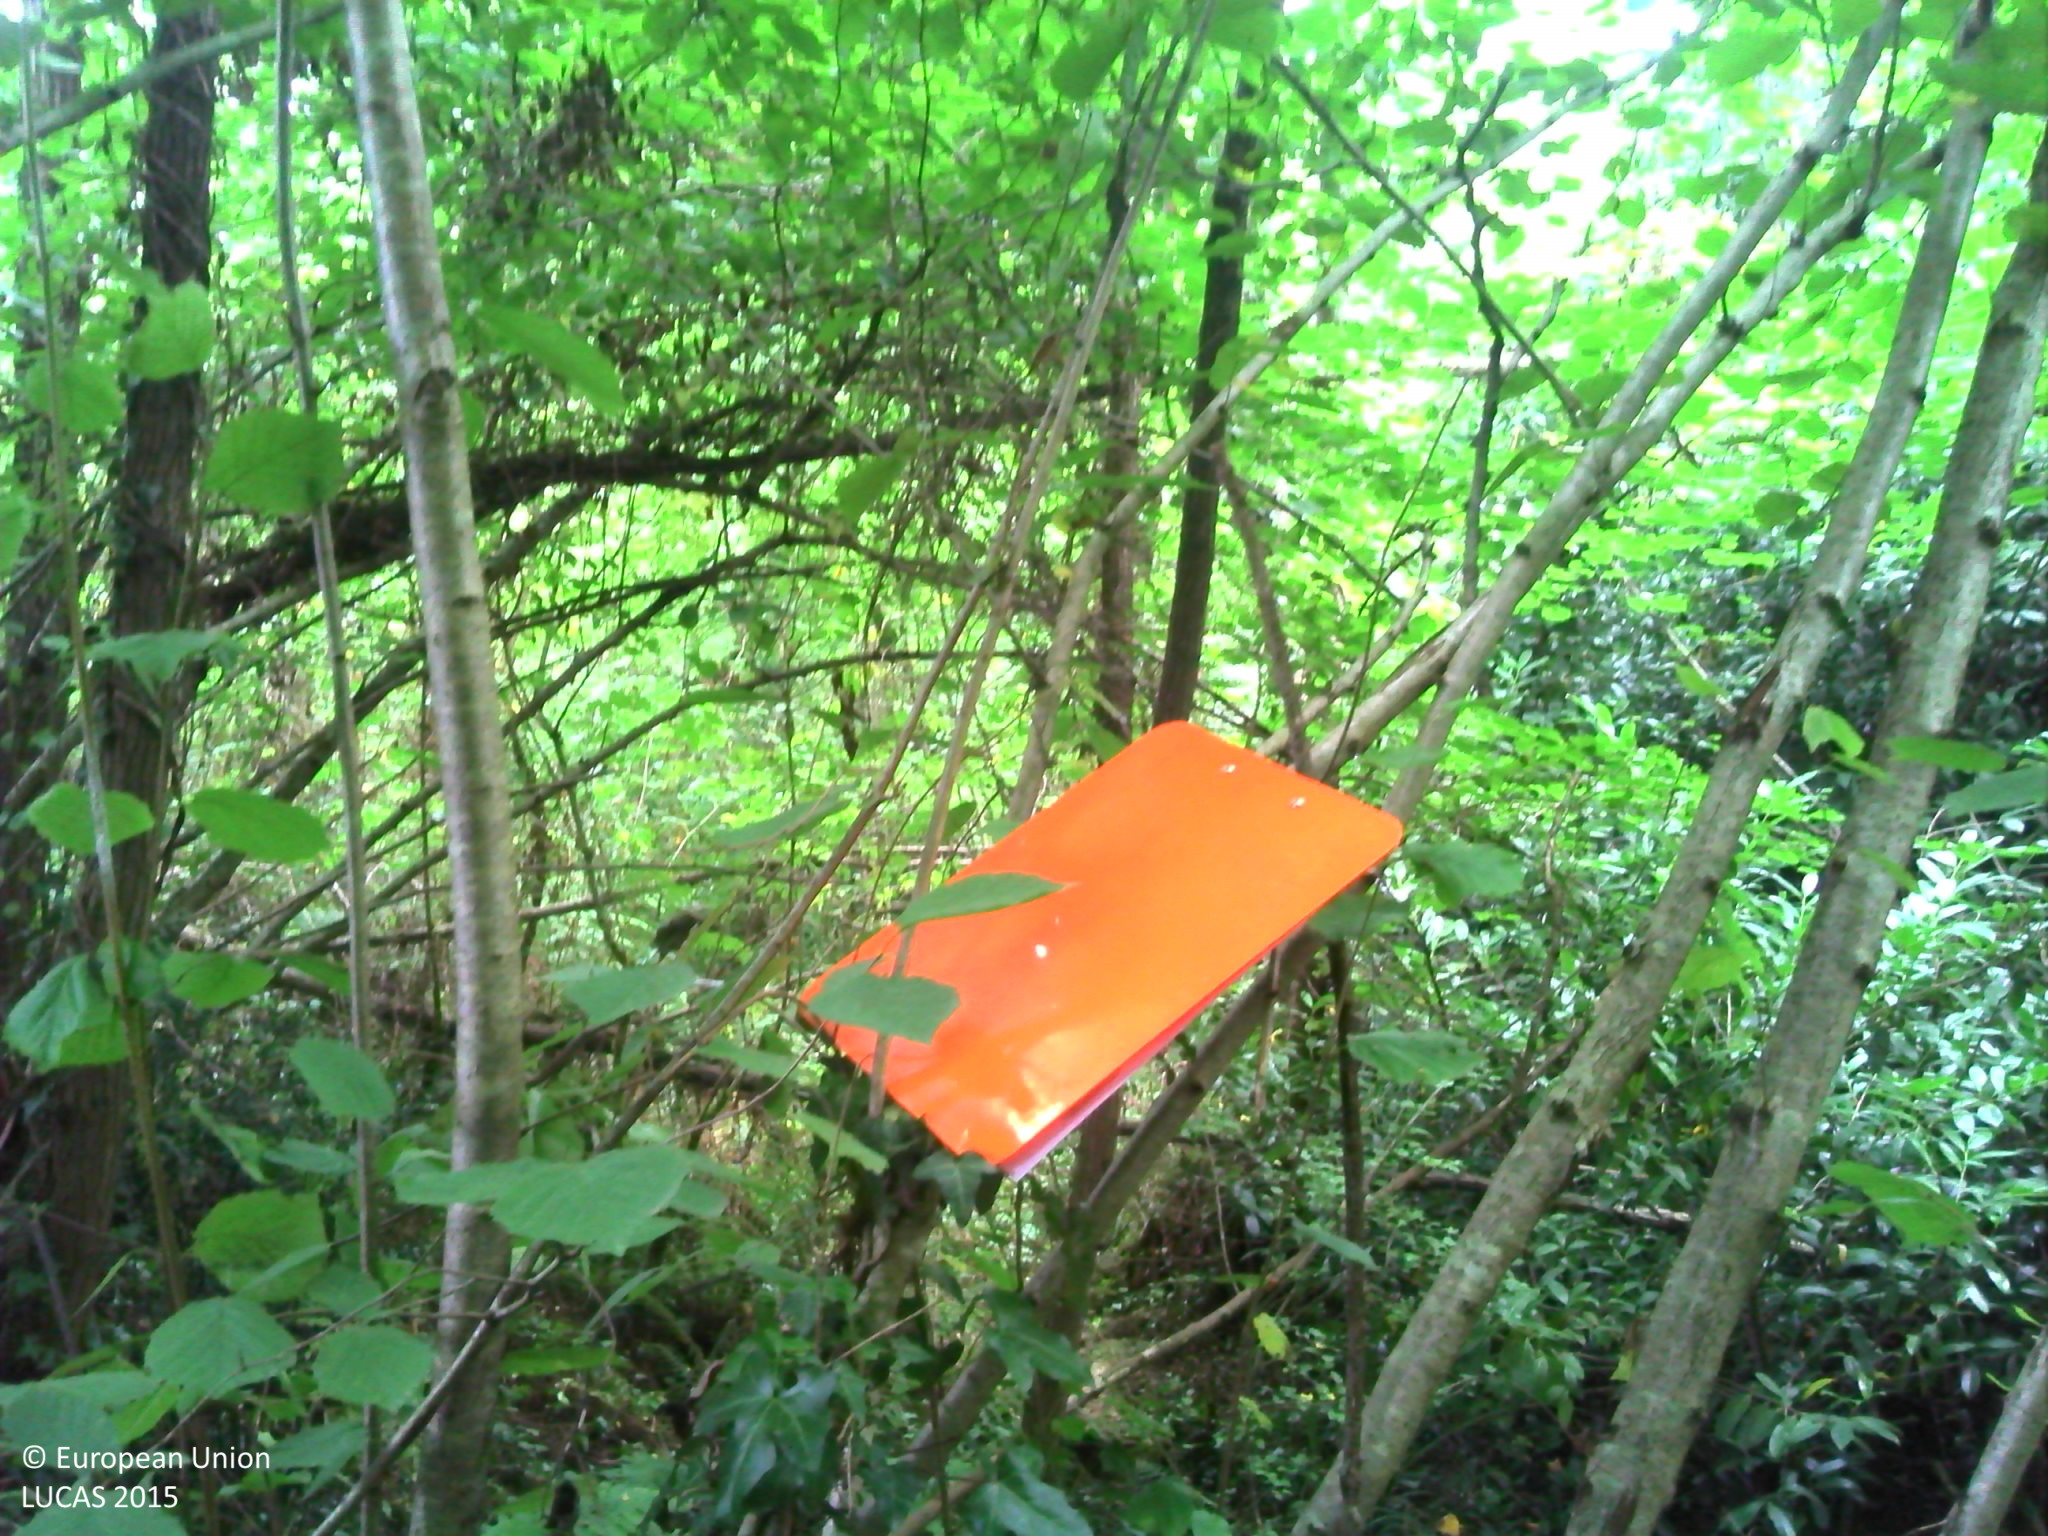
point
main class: Woodland
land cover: Broadleaved woodland
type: acidophilous oak and oak-birch forest
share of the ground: > 75 %
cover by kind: broadleaved forest trees 70 %, shrubs 15 %, herbaceous plants 10 %, lichens and mosses 5 %
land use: Forestry
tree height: > 5 m
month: August
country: FR
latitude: 43.5279
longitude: -1.1637
